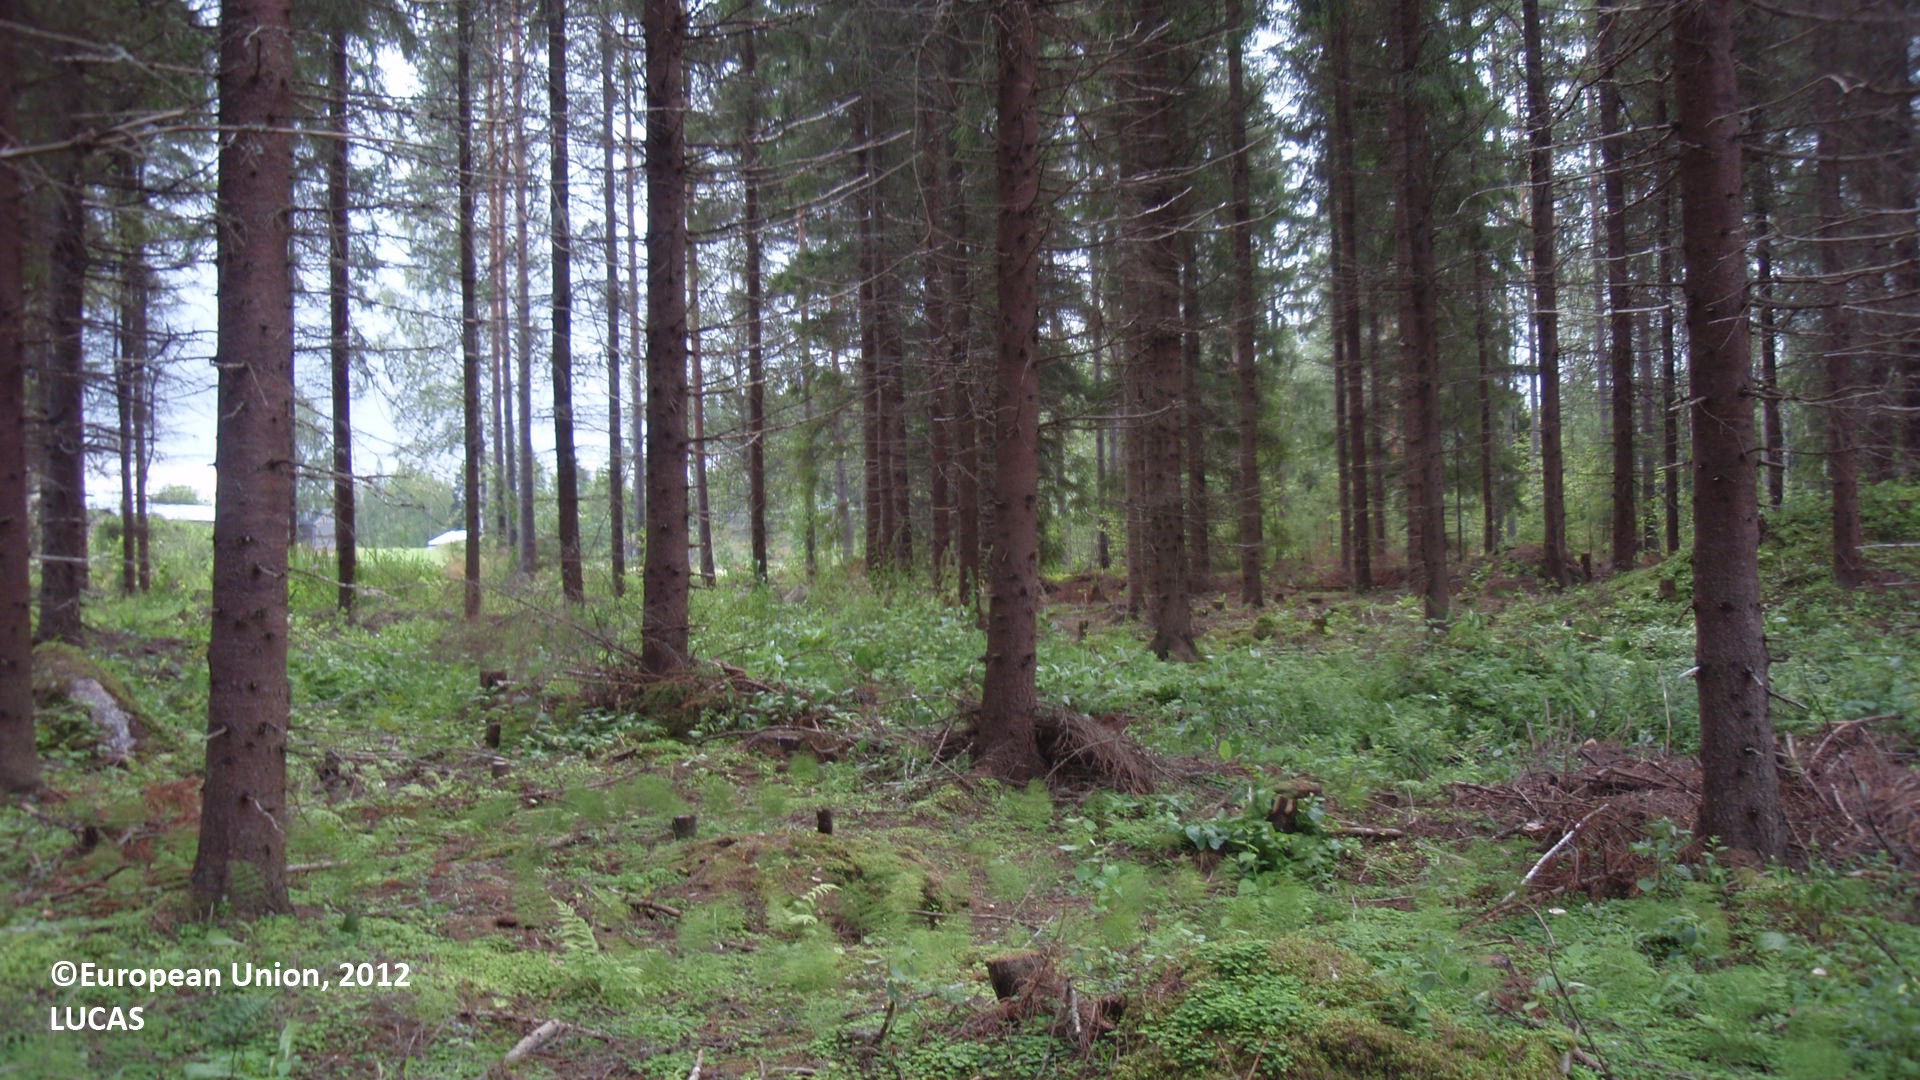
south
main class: Woodland
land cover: Spruce dominated coniferous woodland
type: boreal forest
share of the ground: 50 - 75 %
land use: Forestry
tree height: > 5 m
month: August
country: FI
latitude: 61.0369
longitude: 27.6437
